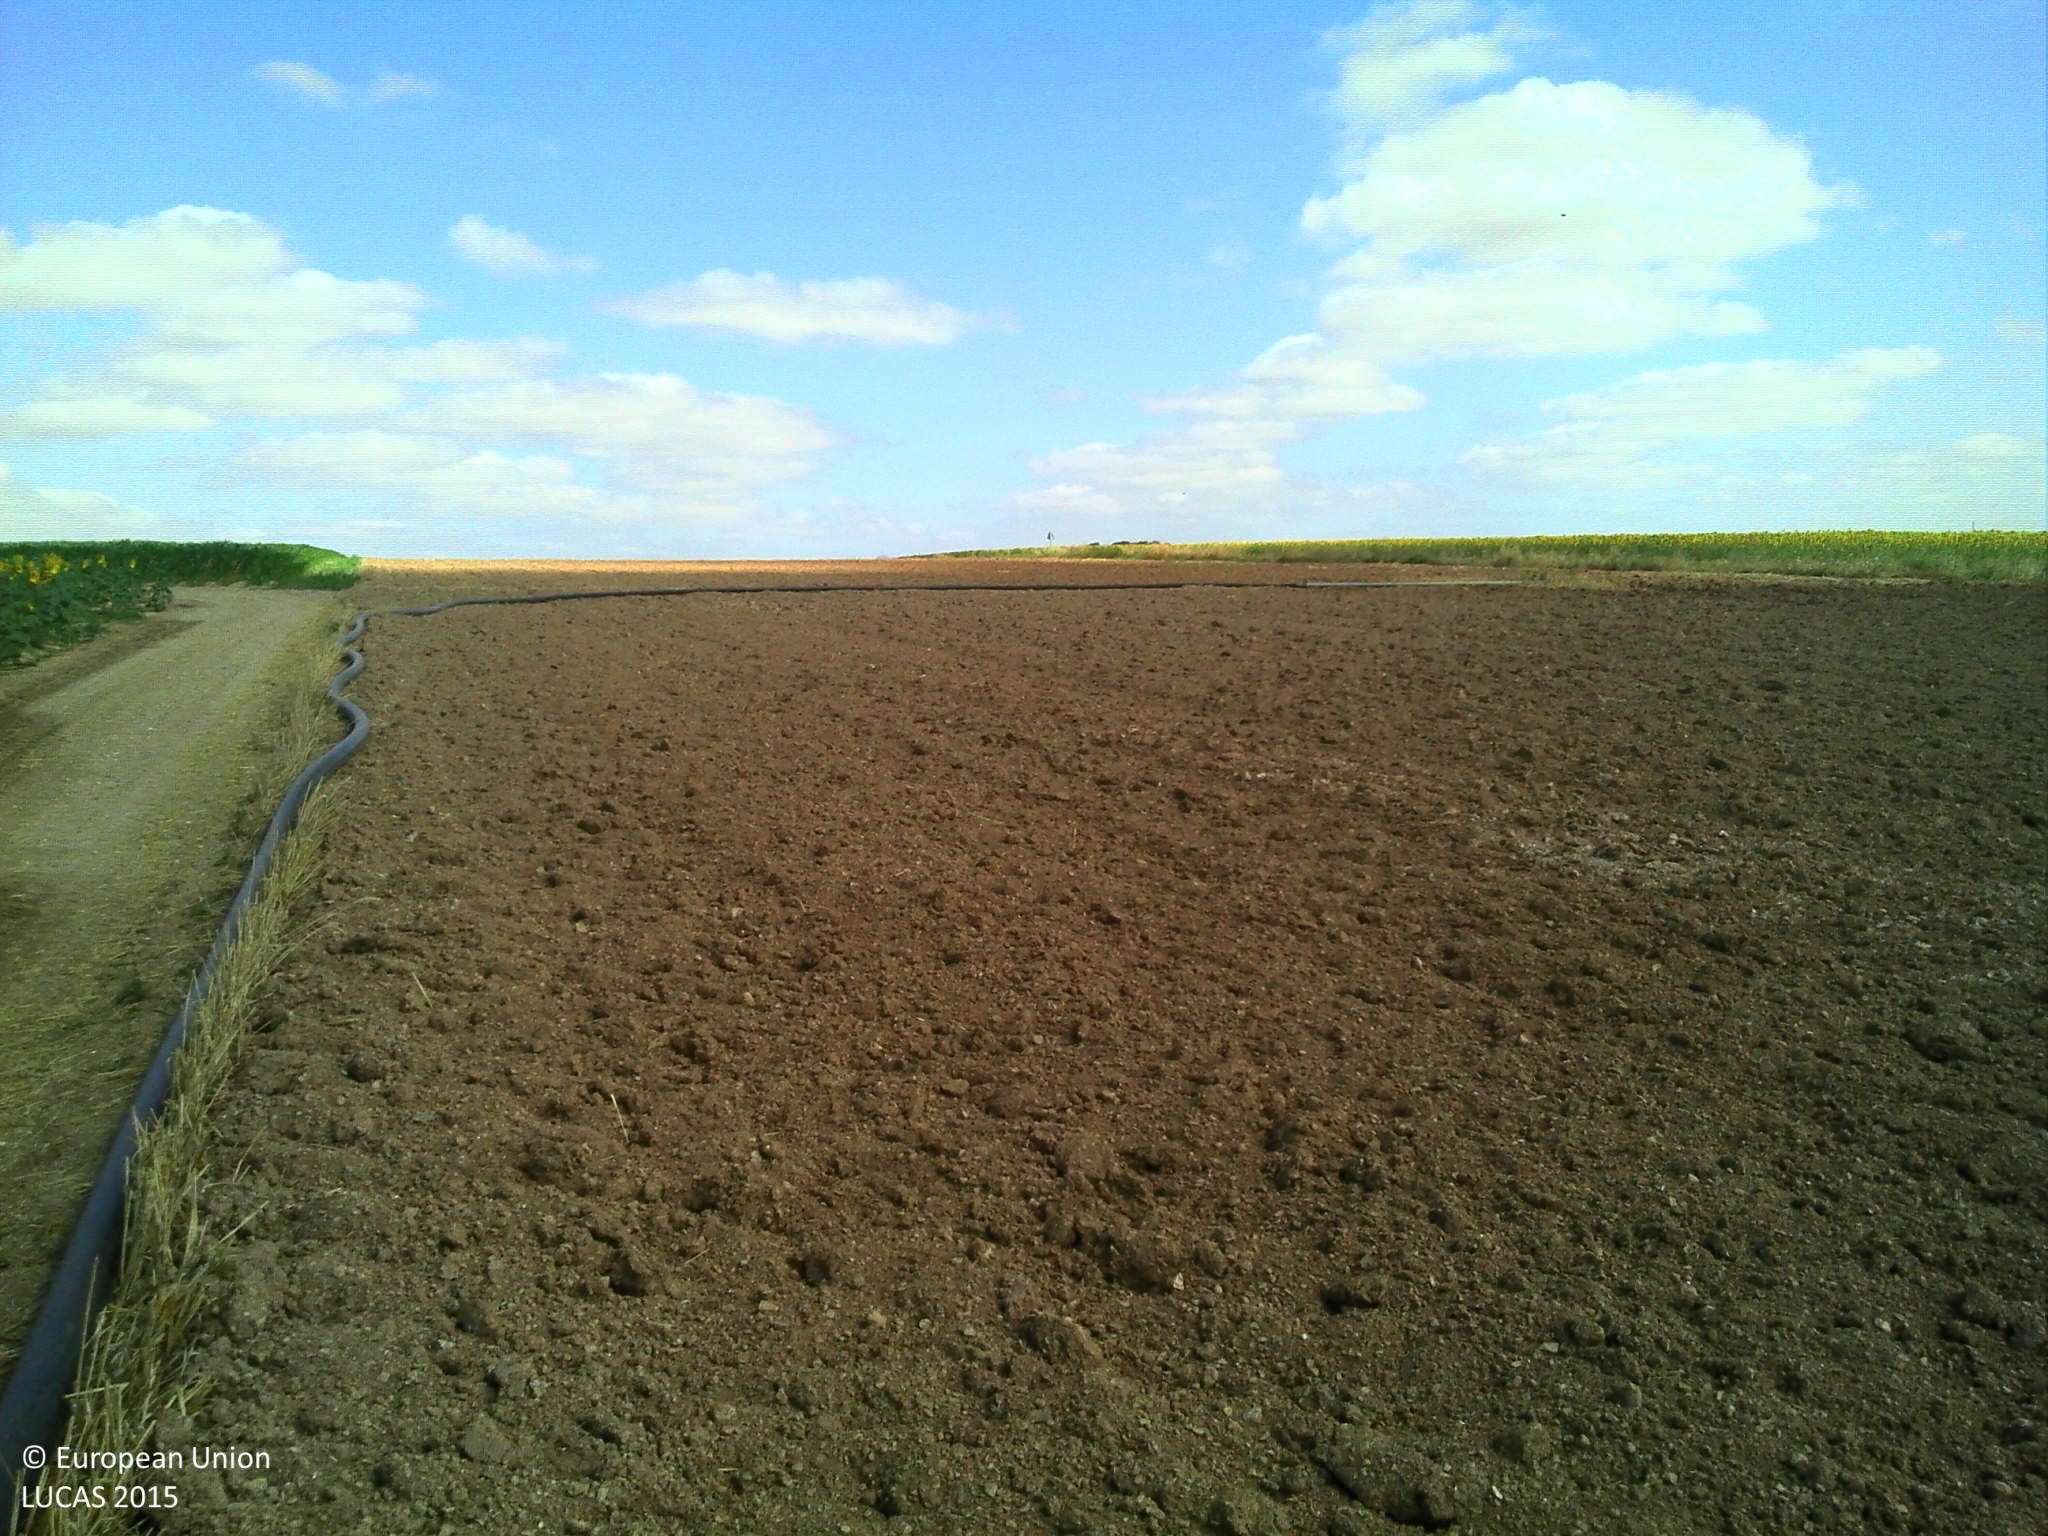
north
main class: Cropland
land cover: Sunflower
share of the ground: > 75 %
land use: Agriculture (excluding fallow land and kitchen gardens)
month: July
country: FR
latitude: 46.6325
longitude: 0.2751
